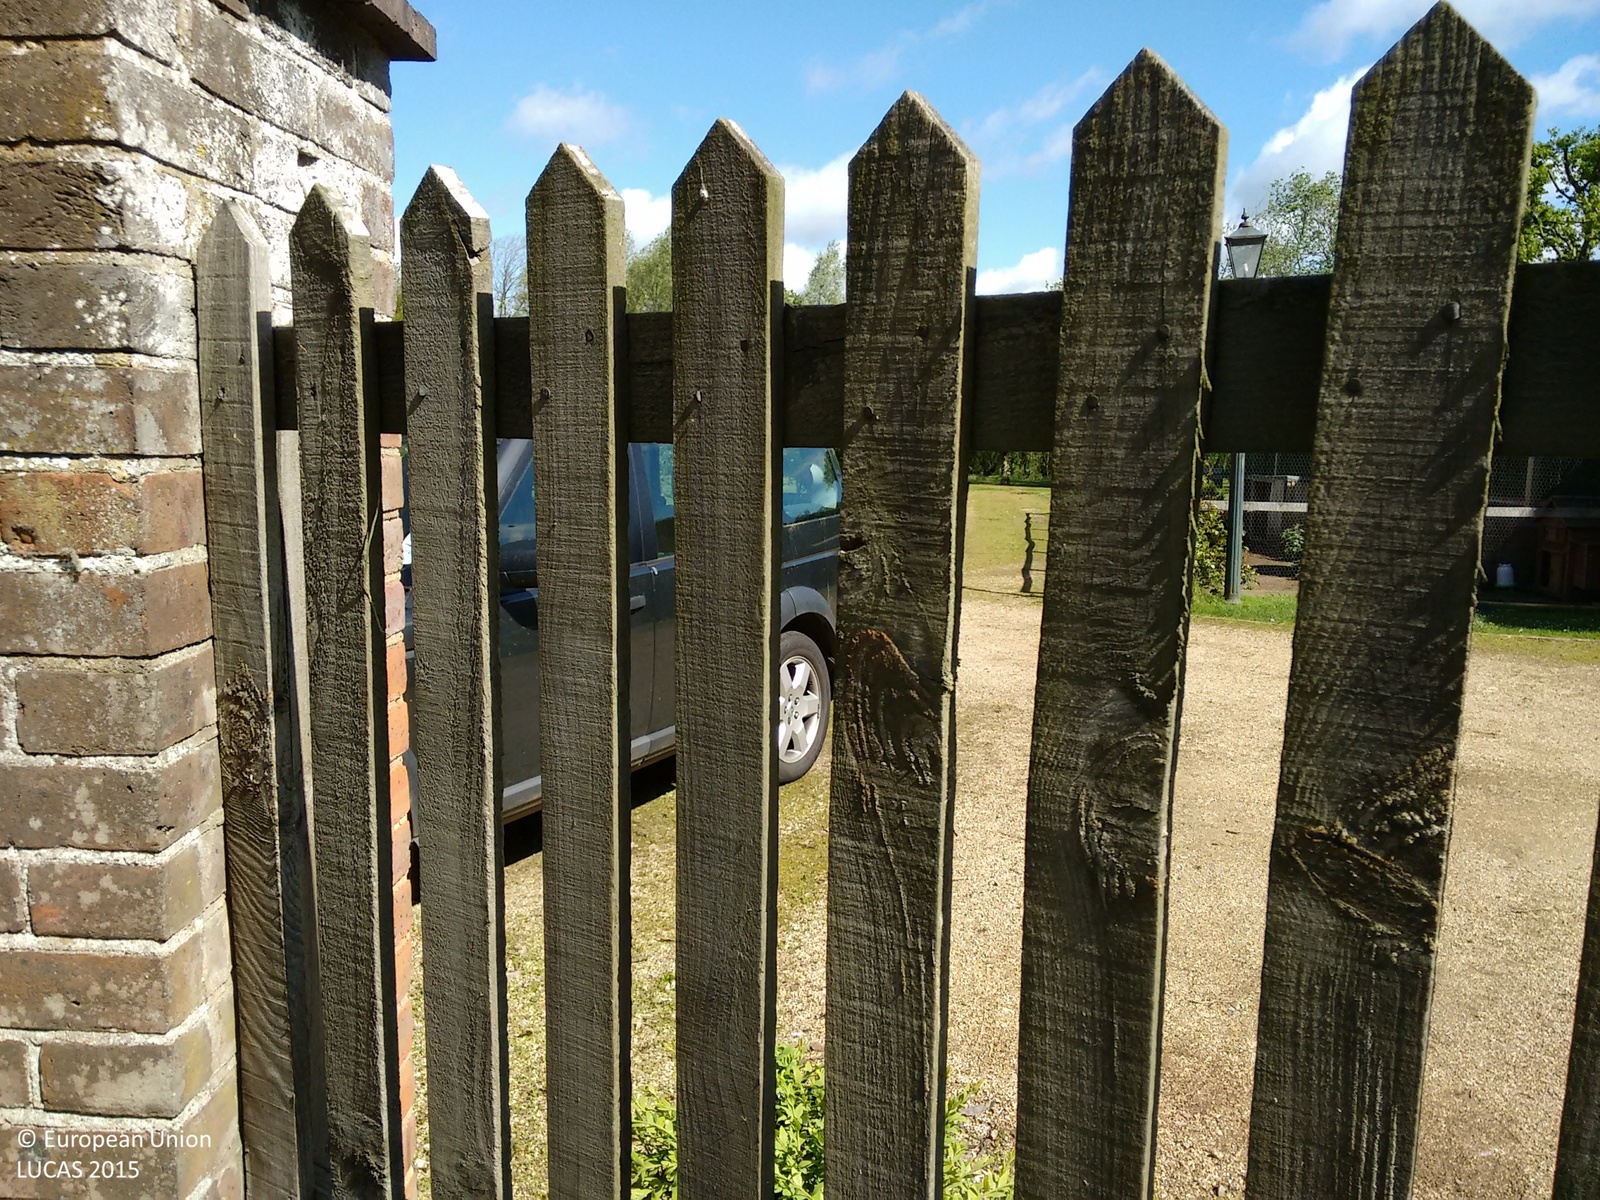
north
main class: Grassland
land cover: Grassland without tree/shrub cover
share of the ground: 25 - 50 %
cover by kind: consolidated bare surface 60 %, herbaceous plants 40 %
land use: Residential
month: May
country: GB
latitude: 51.9646
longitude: -0.5029
